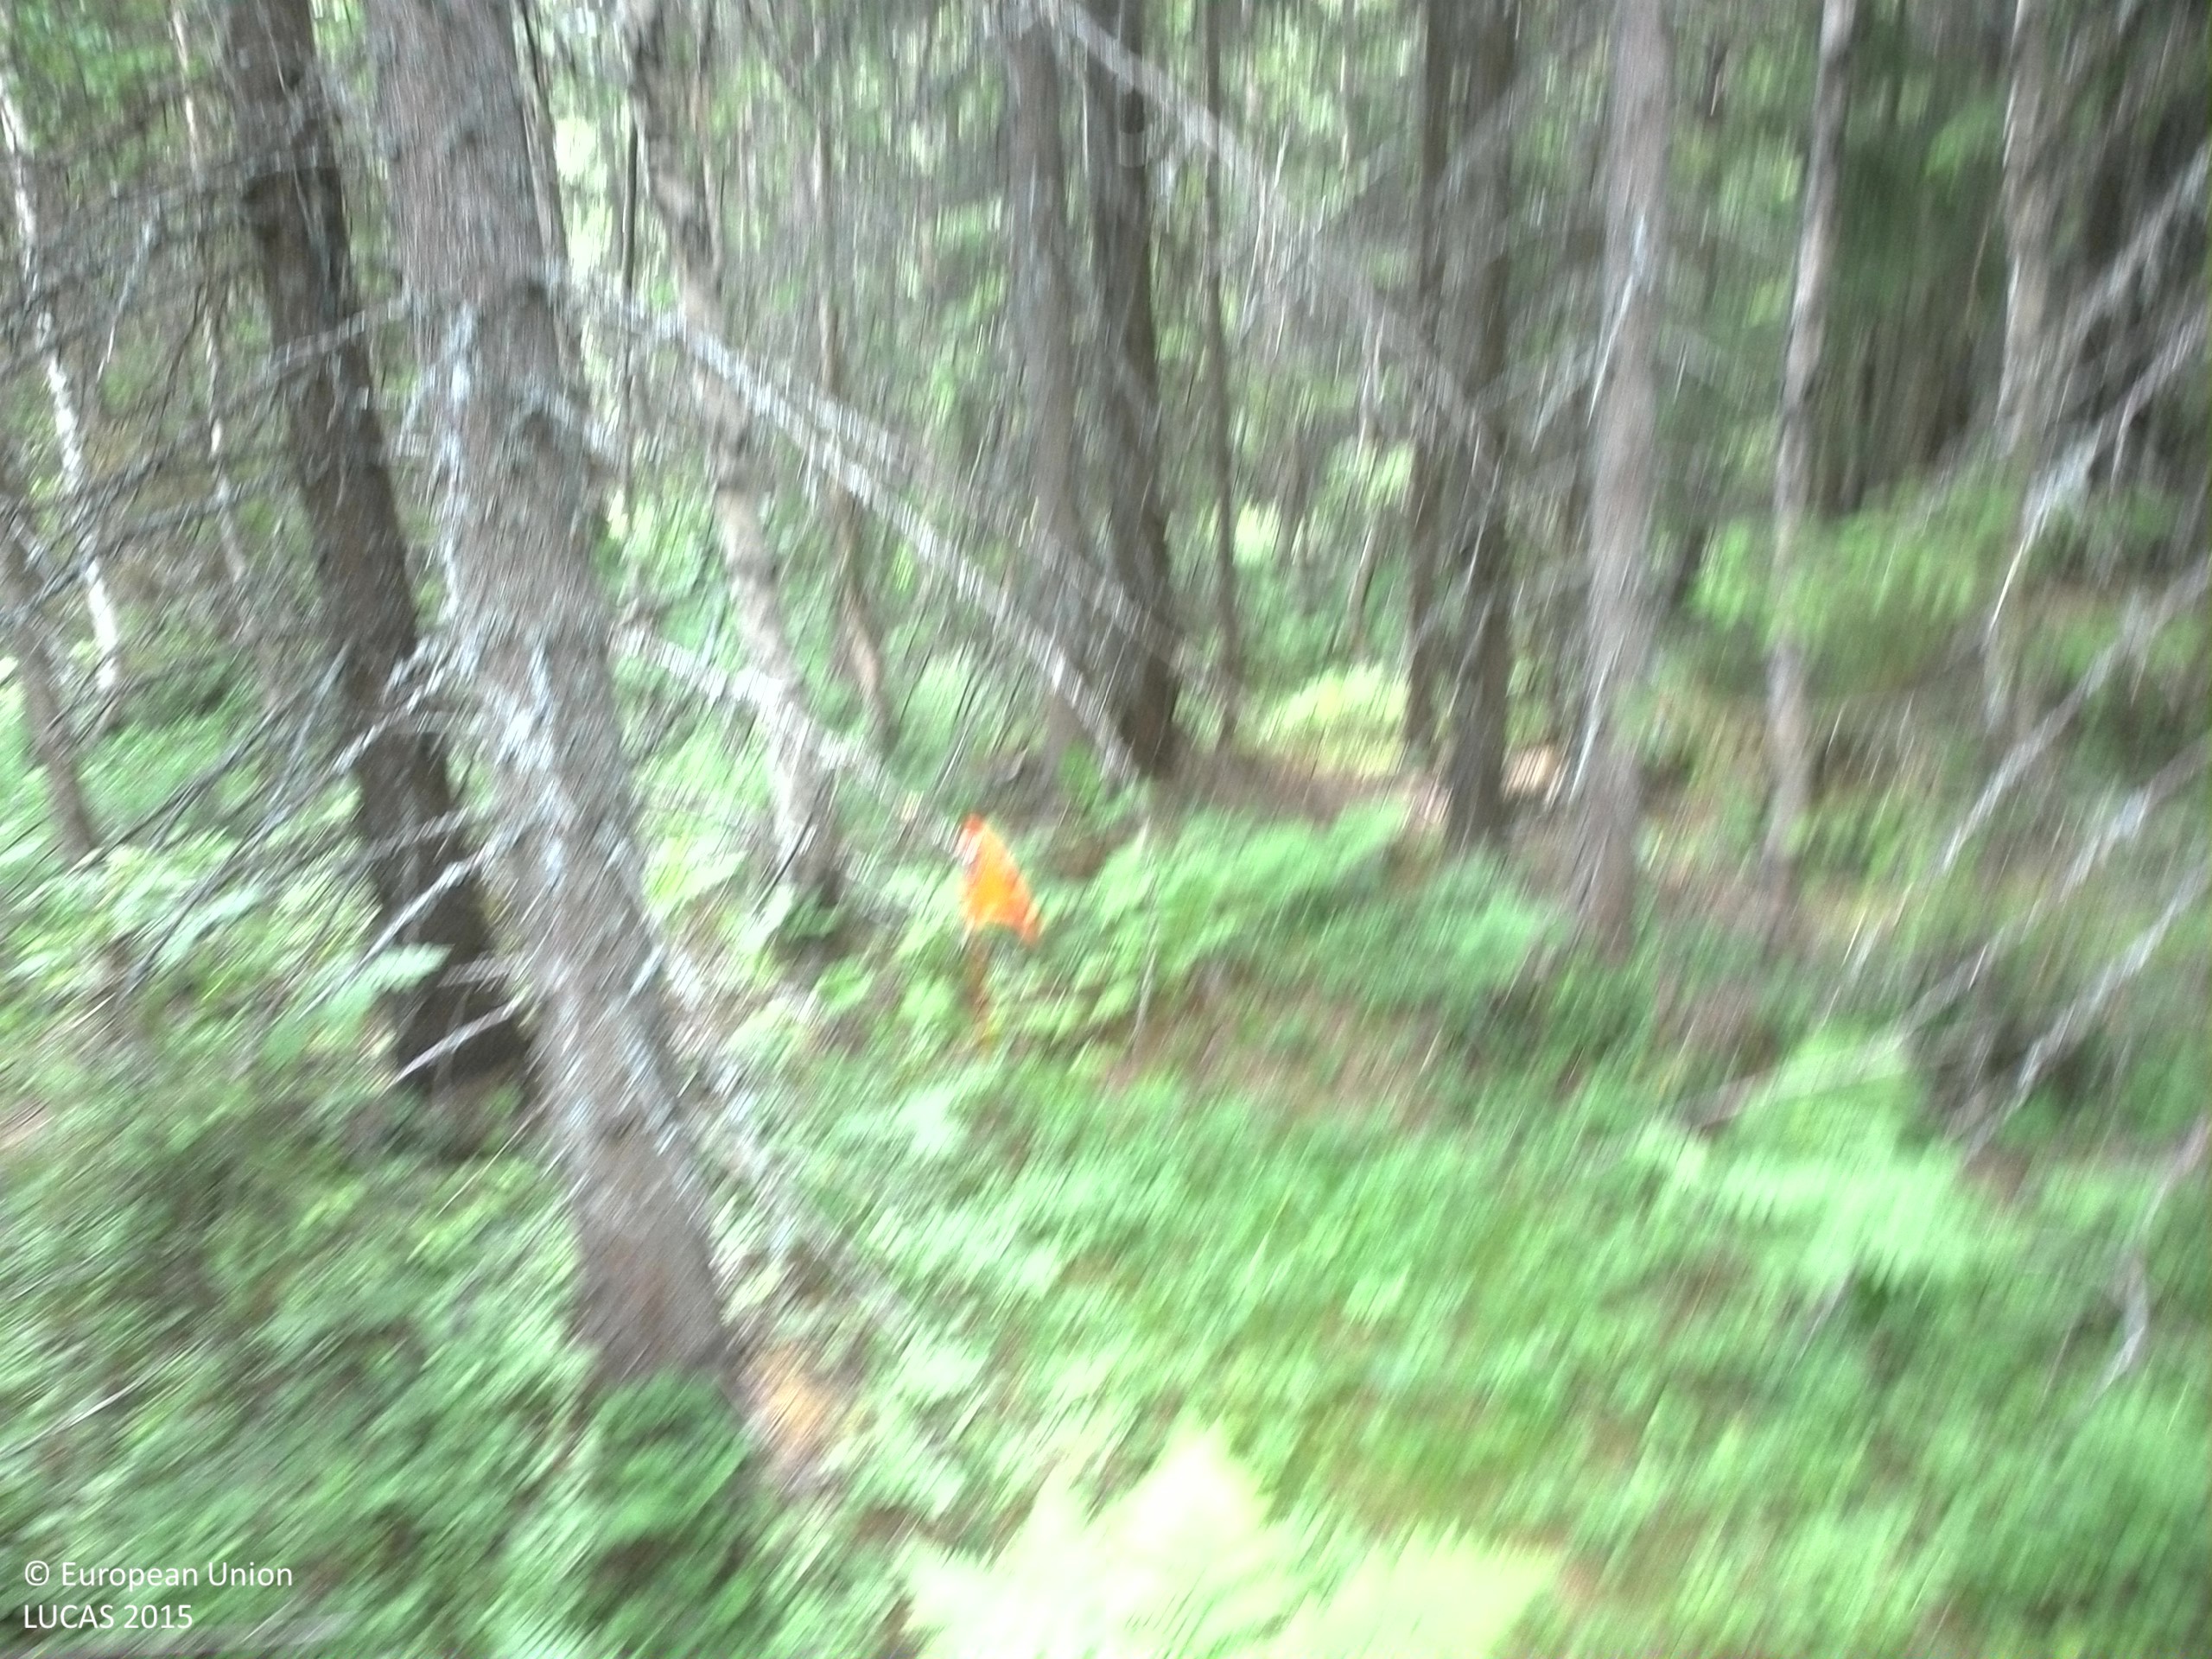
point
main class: Woodland
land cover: Spruce dominated mixed woodland
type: boreal forest
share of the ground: > 75 %
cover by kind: coniferous forest trees 50 %, broadleaved forest trees 25 %, shrubs 20 %, herbaceous plants 5 %
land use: Forestry
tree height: > 5 m
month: July
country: SE
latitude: 62.8166
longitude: 17.6502
